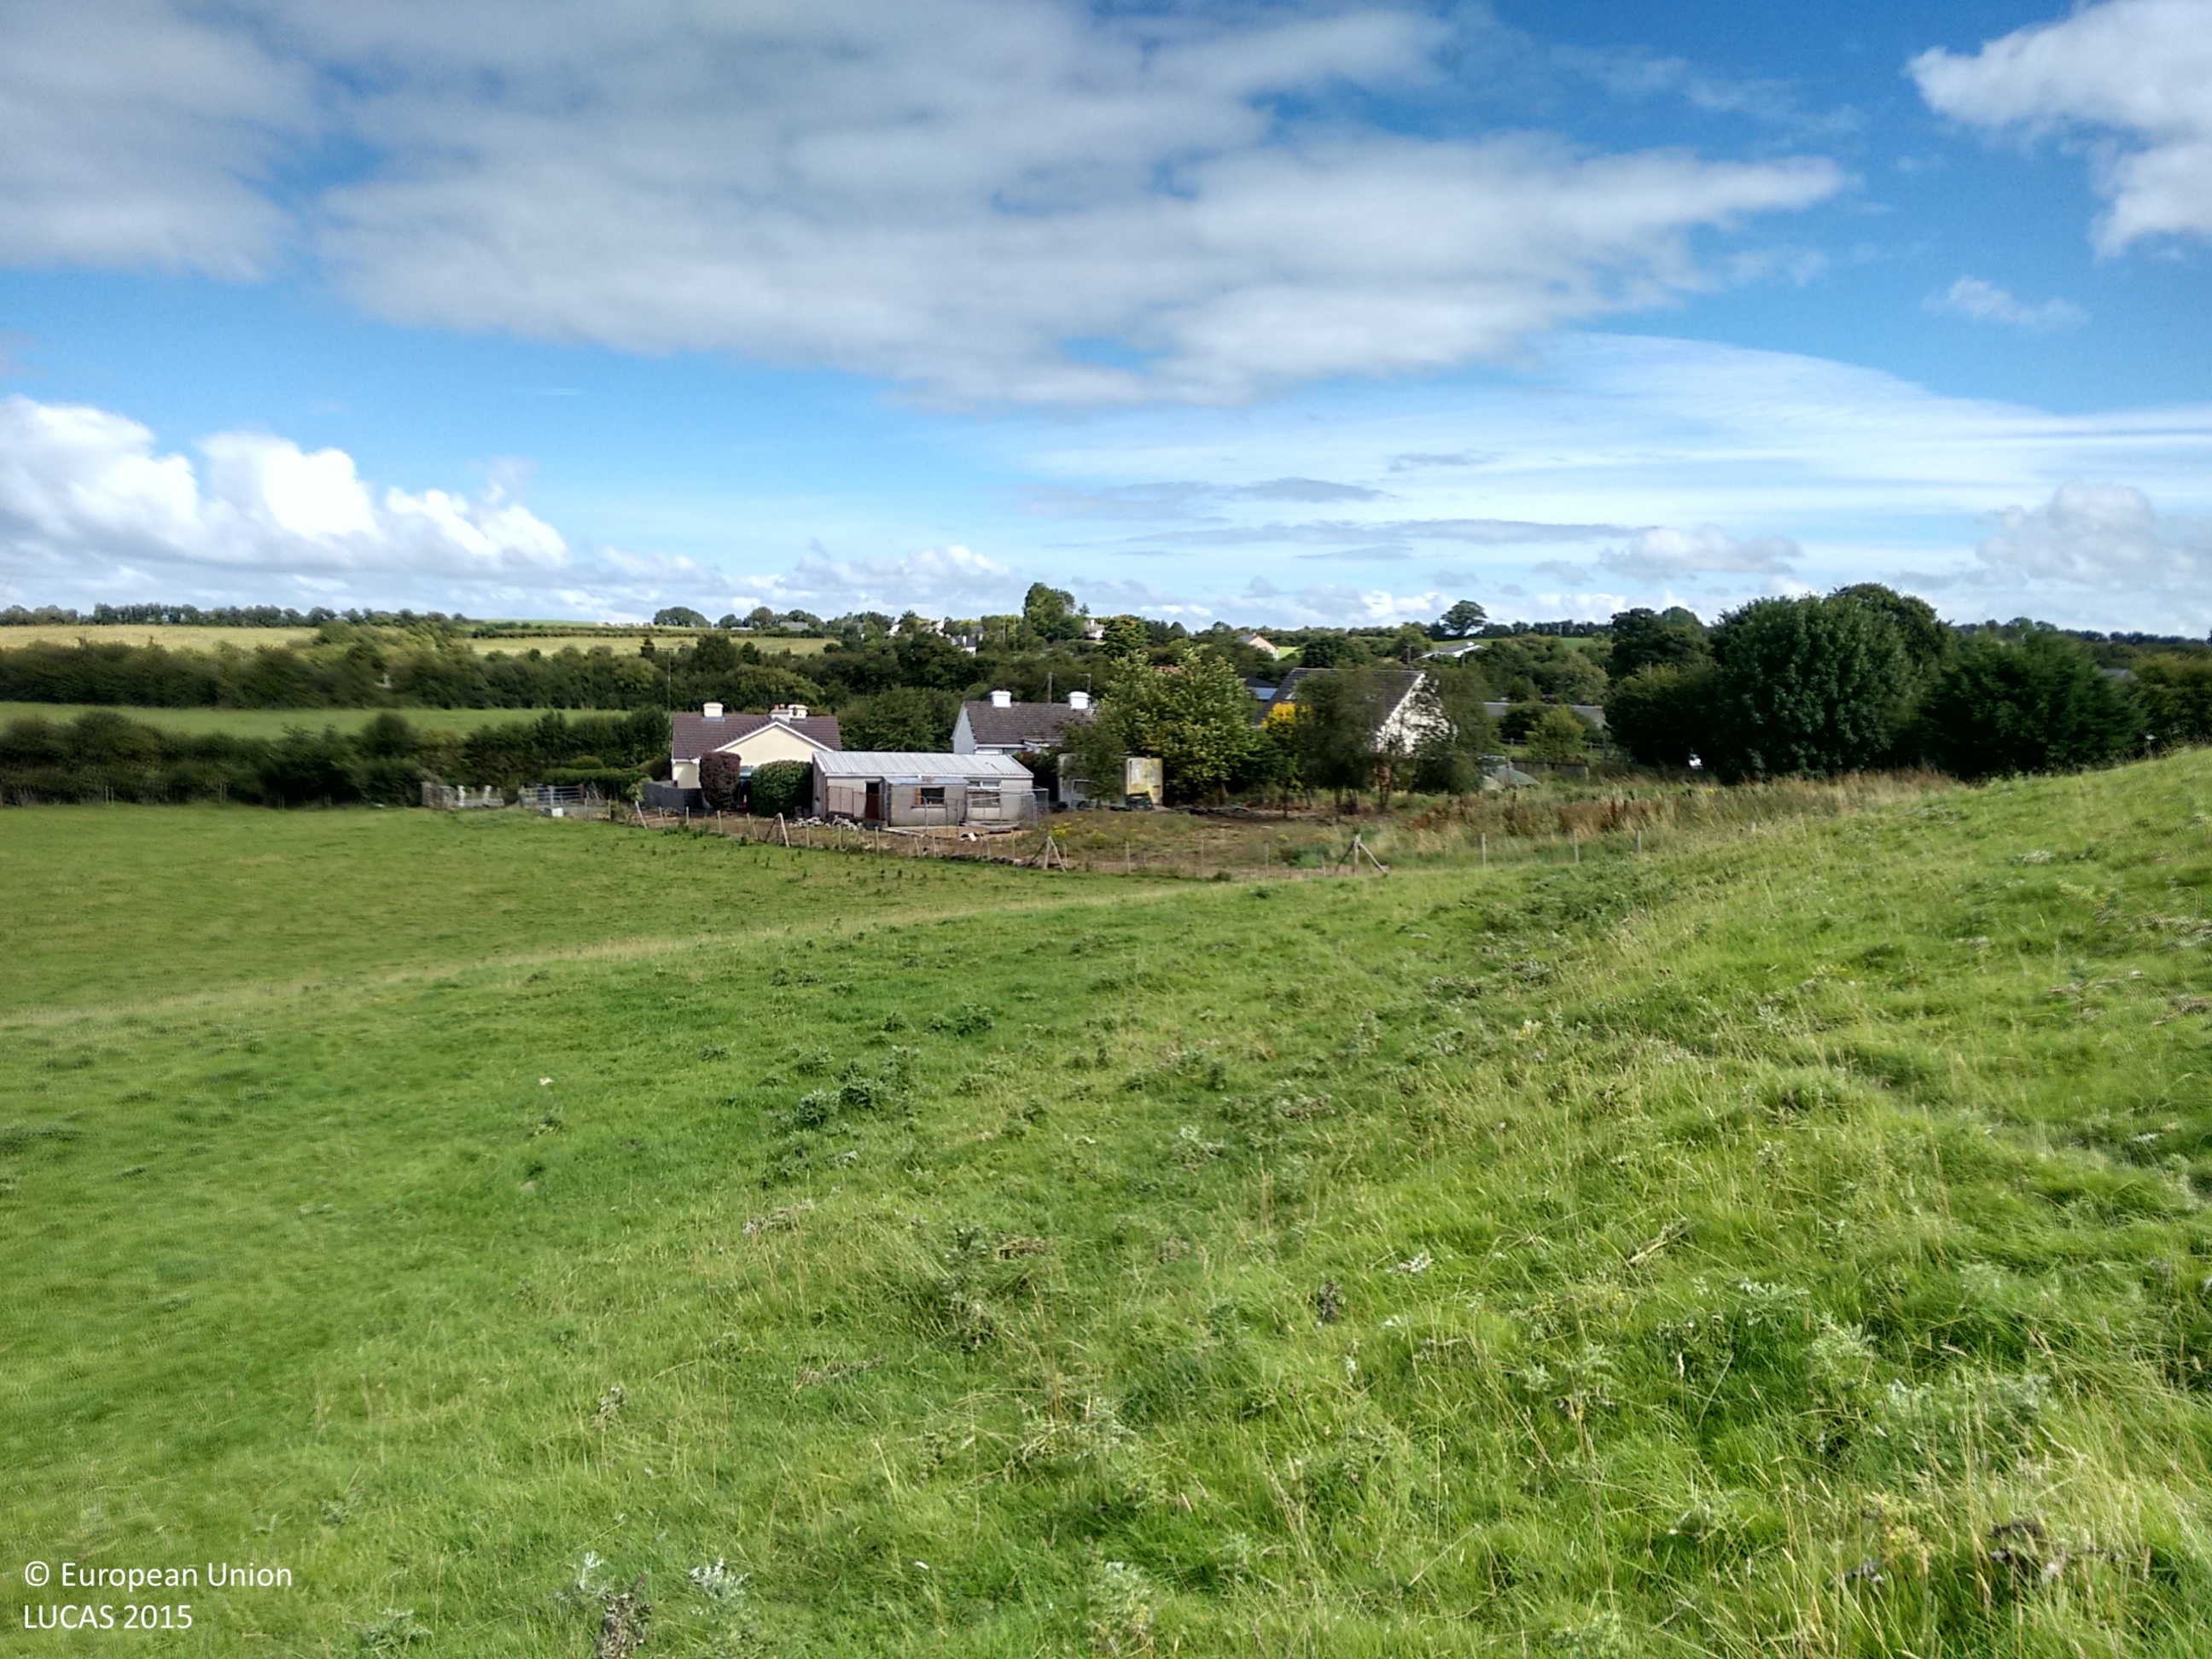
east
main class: Grassland
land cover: Grassland without tree/shrub cover
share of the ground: > 75 %
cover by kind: herbaceous plants 100 %
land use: Agriculture (excluding fallow land and kitchen gardens)
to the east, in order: Grassland without tree/shrub cover; Artificial constructions in urban areas; Managed hedges; Grassland without tree/shrub cover; Managed hedges; Artificial constructions in urban areas
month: August
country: IE
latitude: 53.3507
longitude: -7.6030
